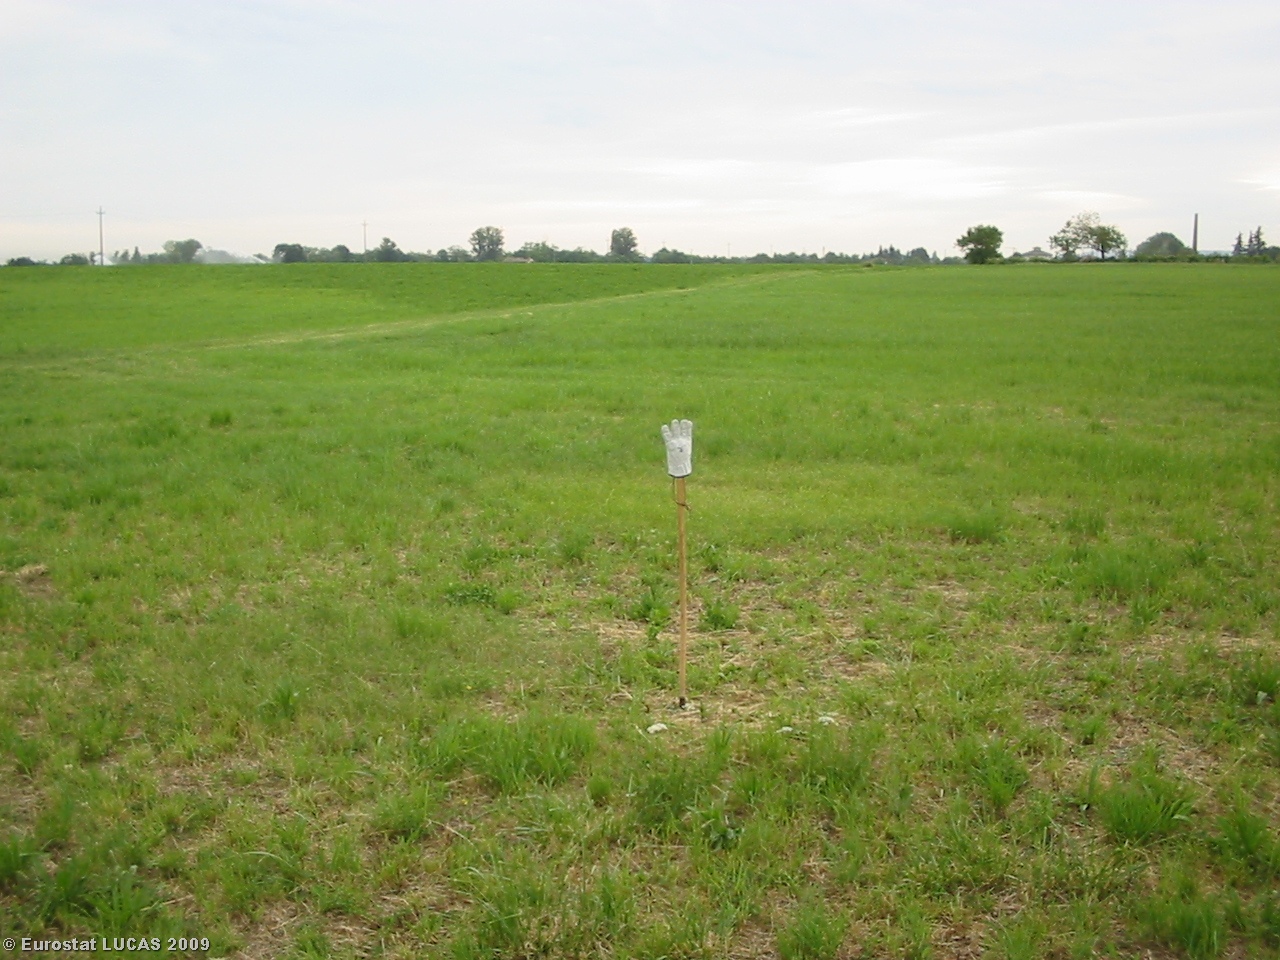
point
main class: Grassland
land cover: Grassland without tree/shrub cover
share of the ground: > 75 %
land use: Agriculture (excluding fallow land and kitchen gardens)
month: June
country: IT
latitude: 44.6929
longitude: 10.2644
